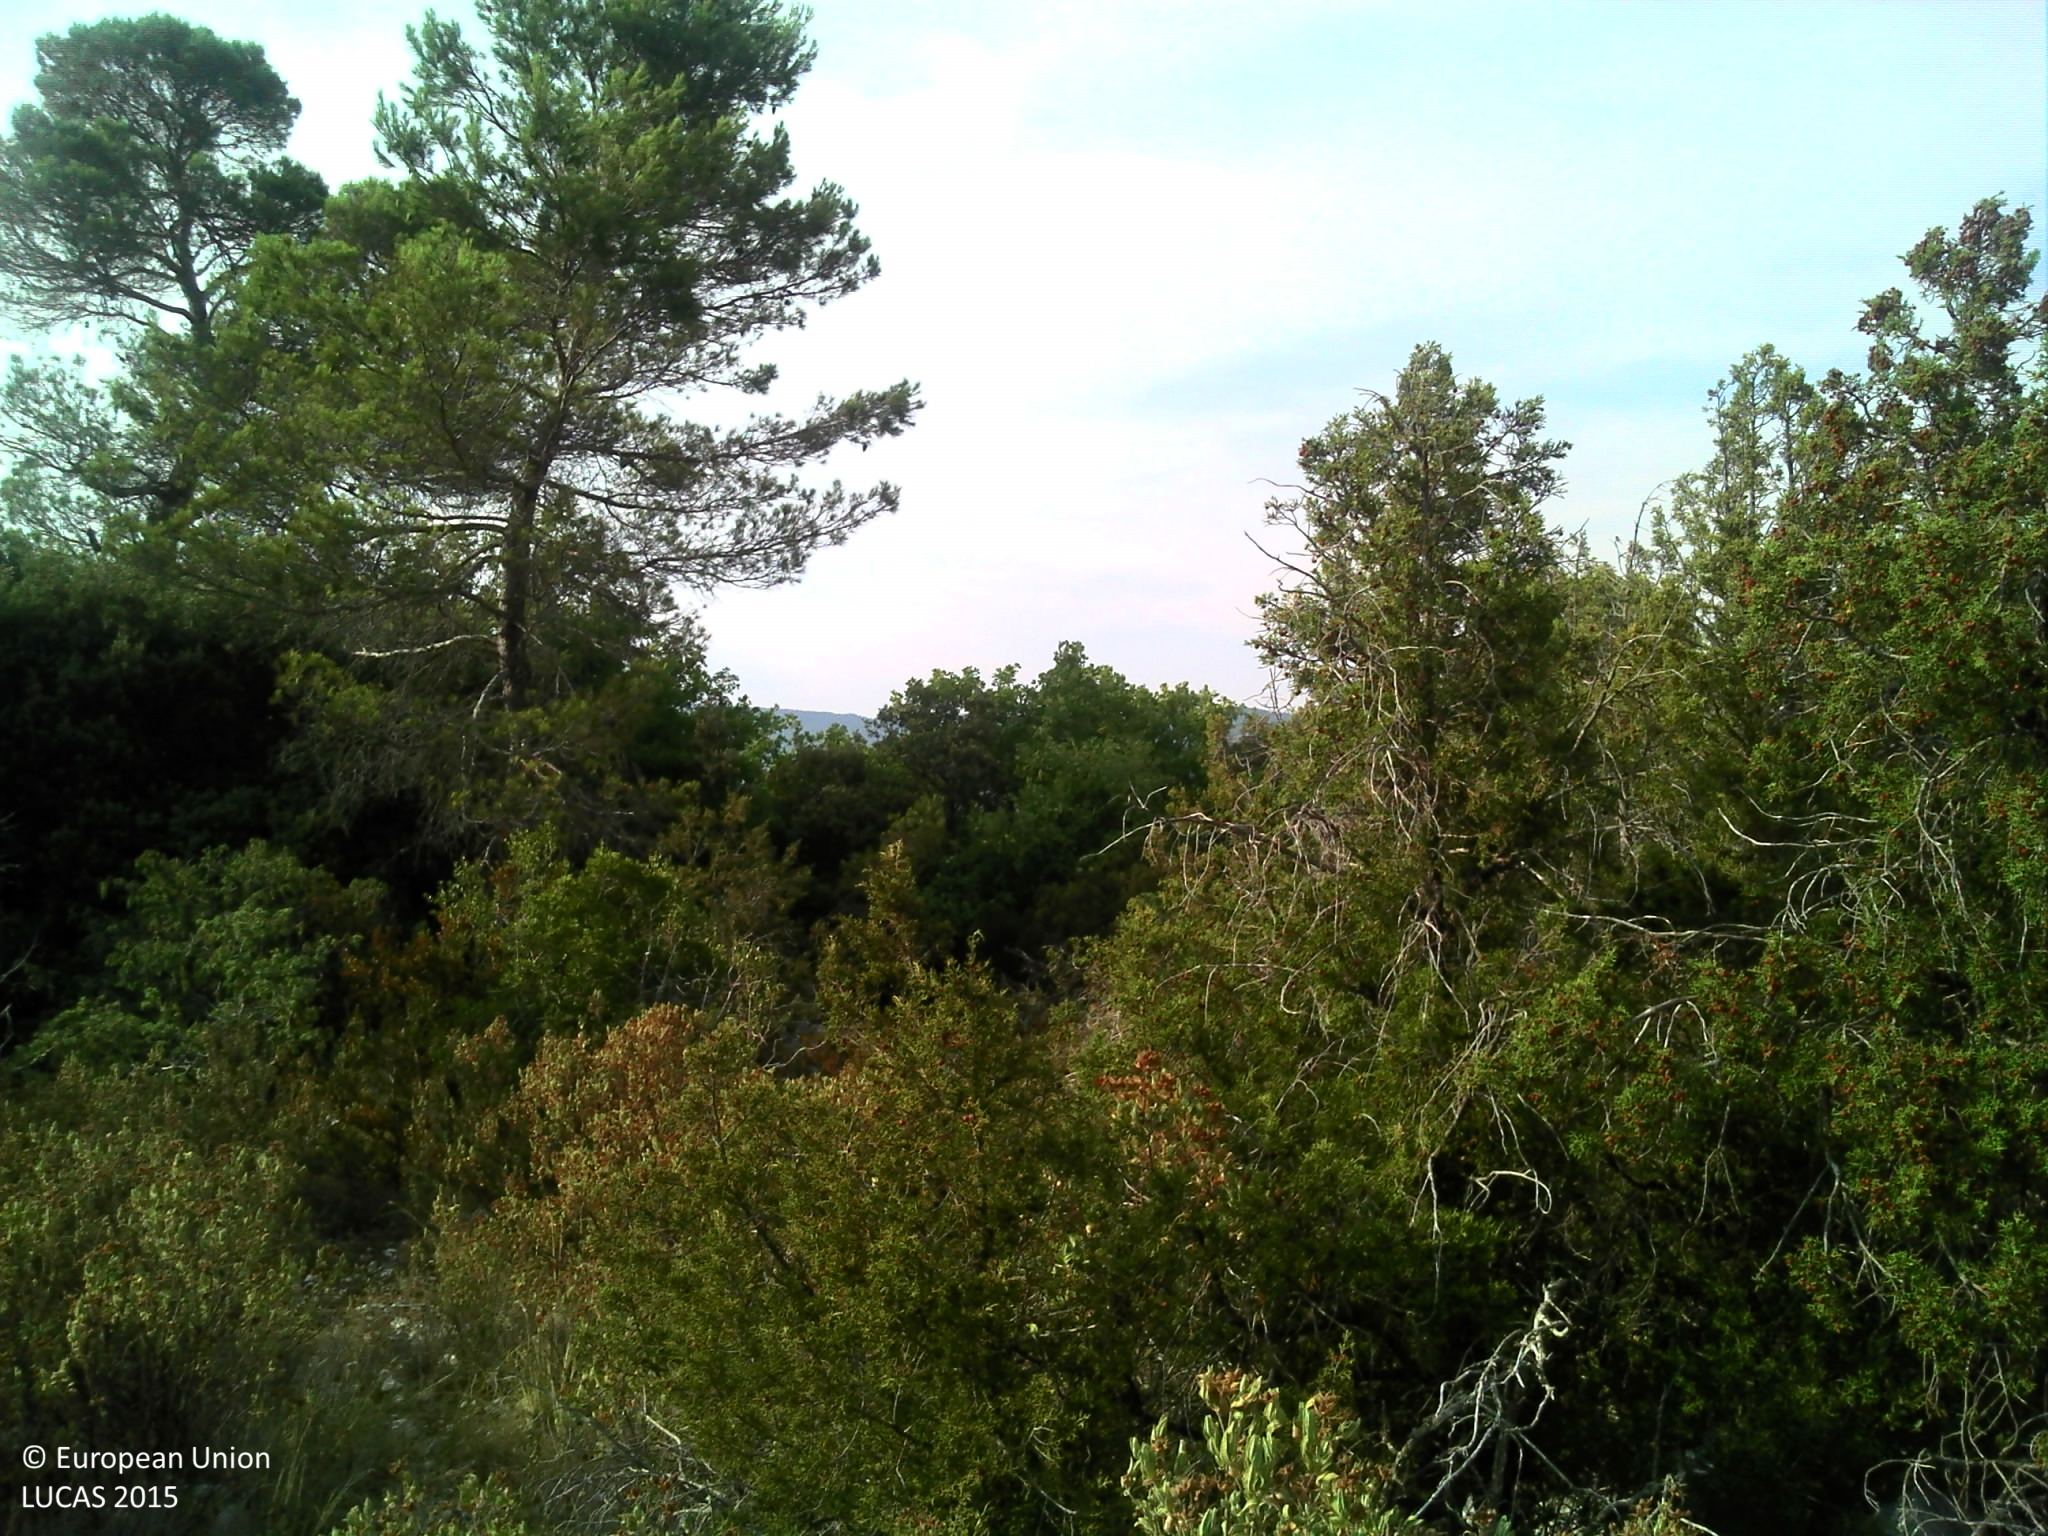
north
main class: Shrubland
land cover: Shrubland without tree cover
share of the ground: > 75 %
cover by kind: shrubs 70 %, unconsolidated bare surface 30 %
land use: Semi-natural and natural areas not in use
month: August
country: FR
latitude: 43.6012
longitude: 6.3787
